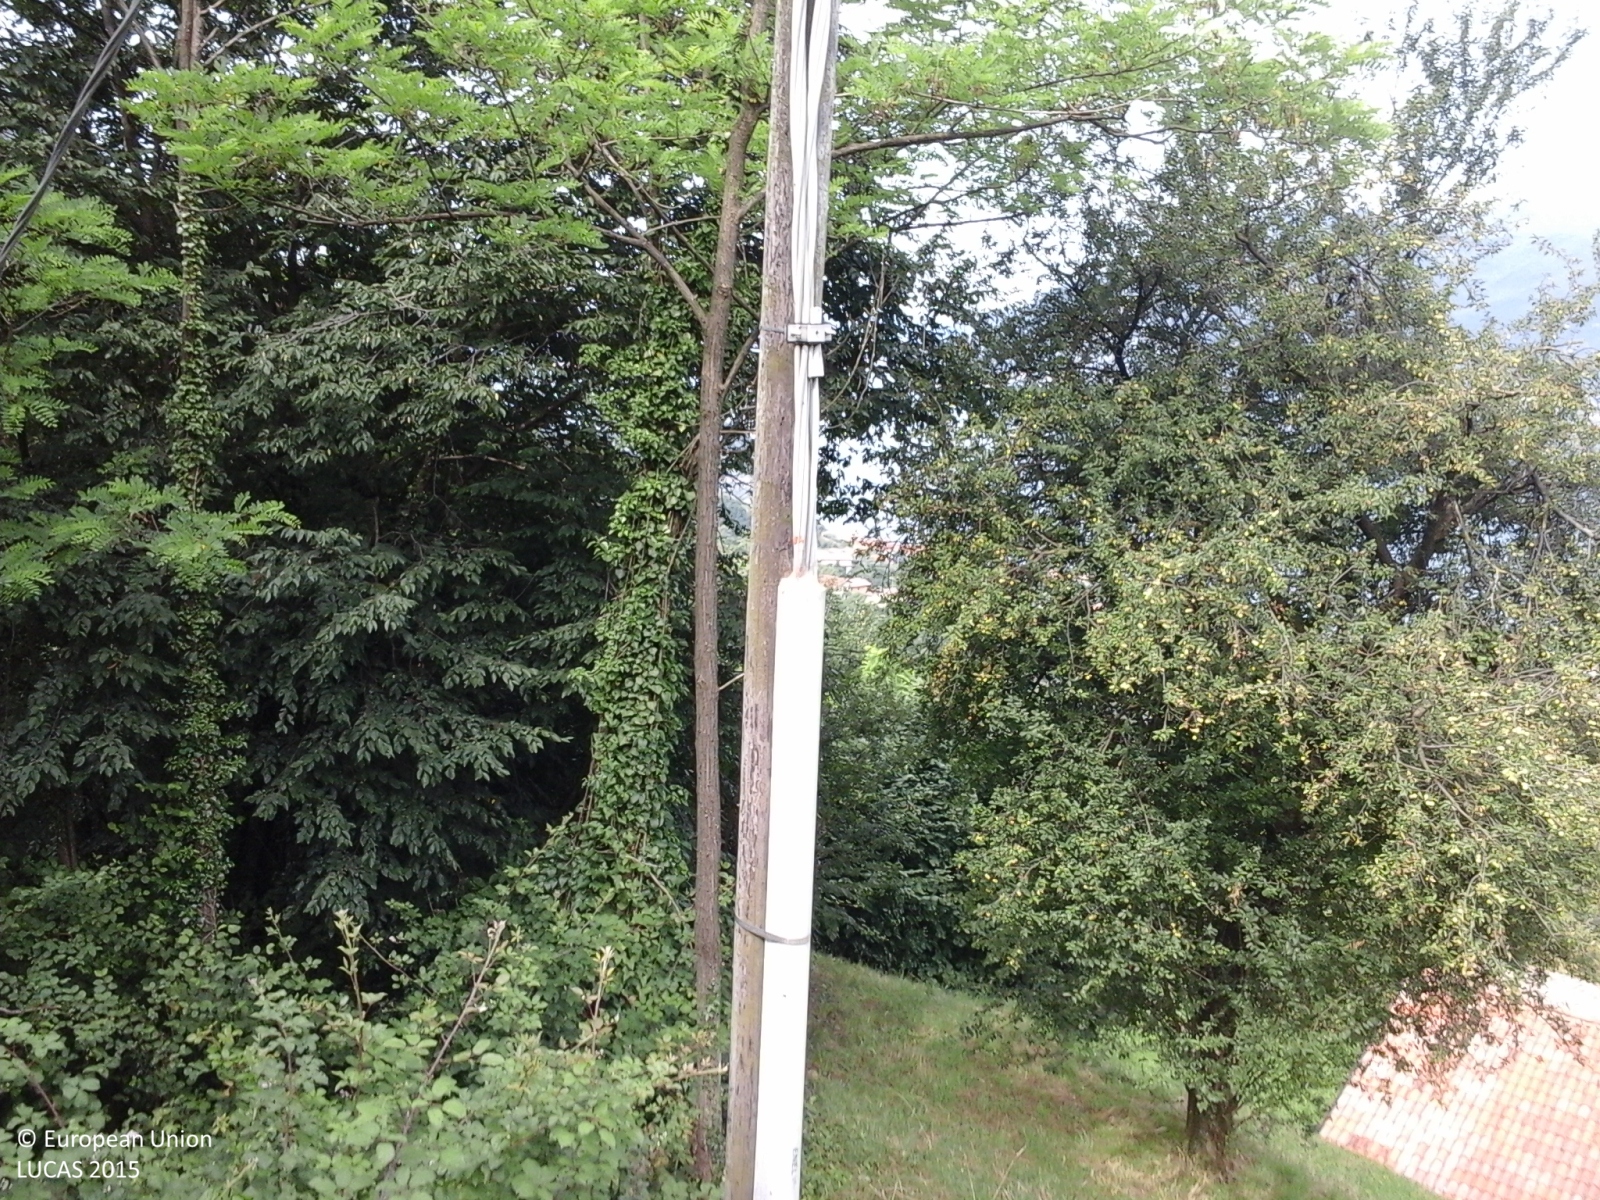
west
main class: Woodland
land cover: Broadleaved woodland
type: thermophilous deciduous forest
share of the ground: > 75 %
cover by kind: broadleaved forest trees 100 %
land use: Semi-natural and natural areas not in use
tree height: > 5 m
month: June
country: IT
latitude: 45.6845
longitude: 10.1154
